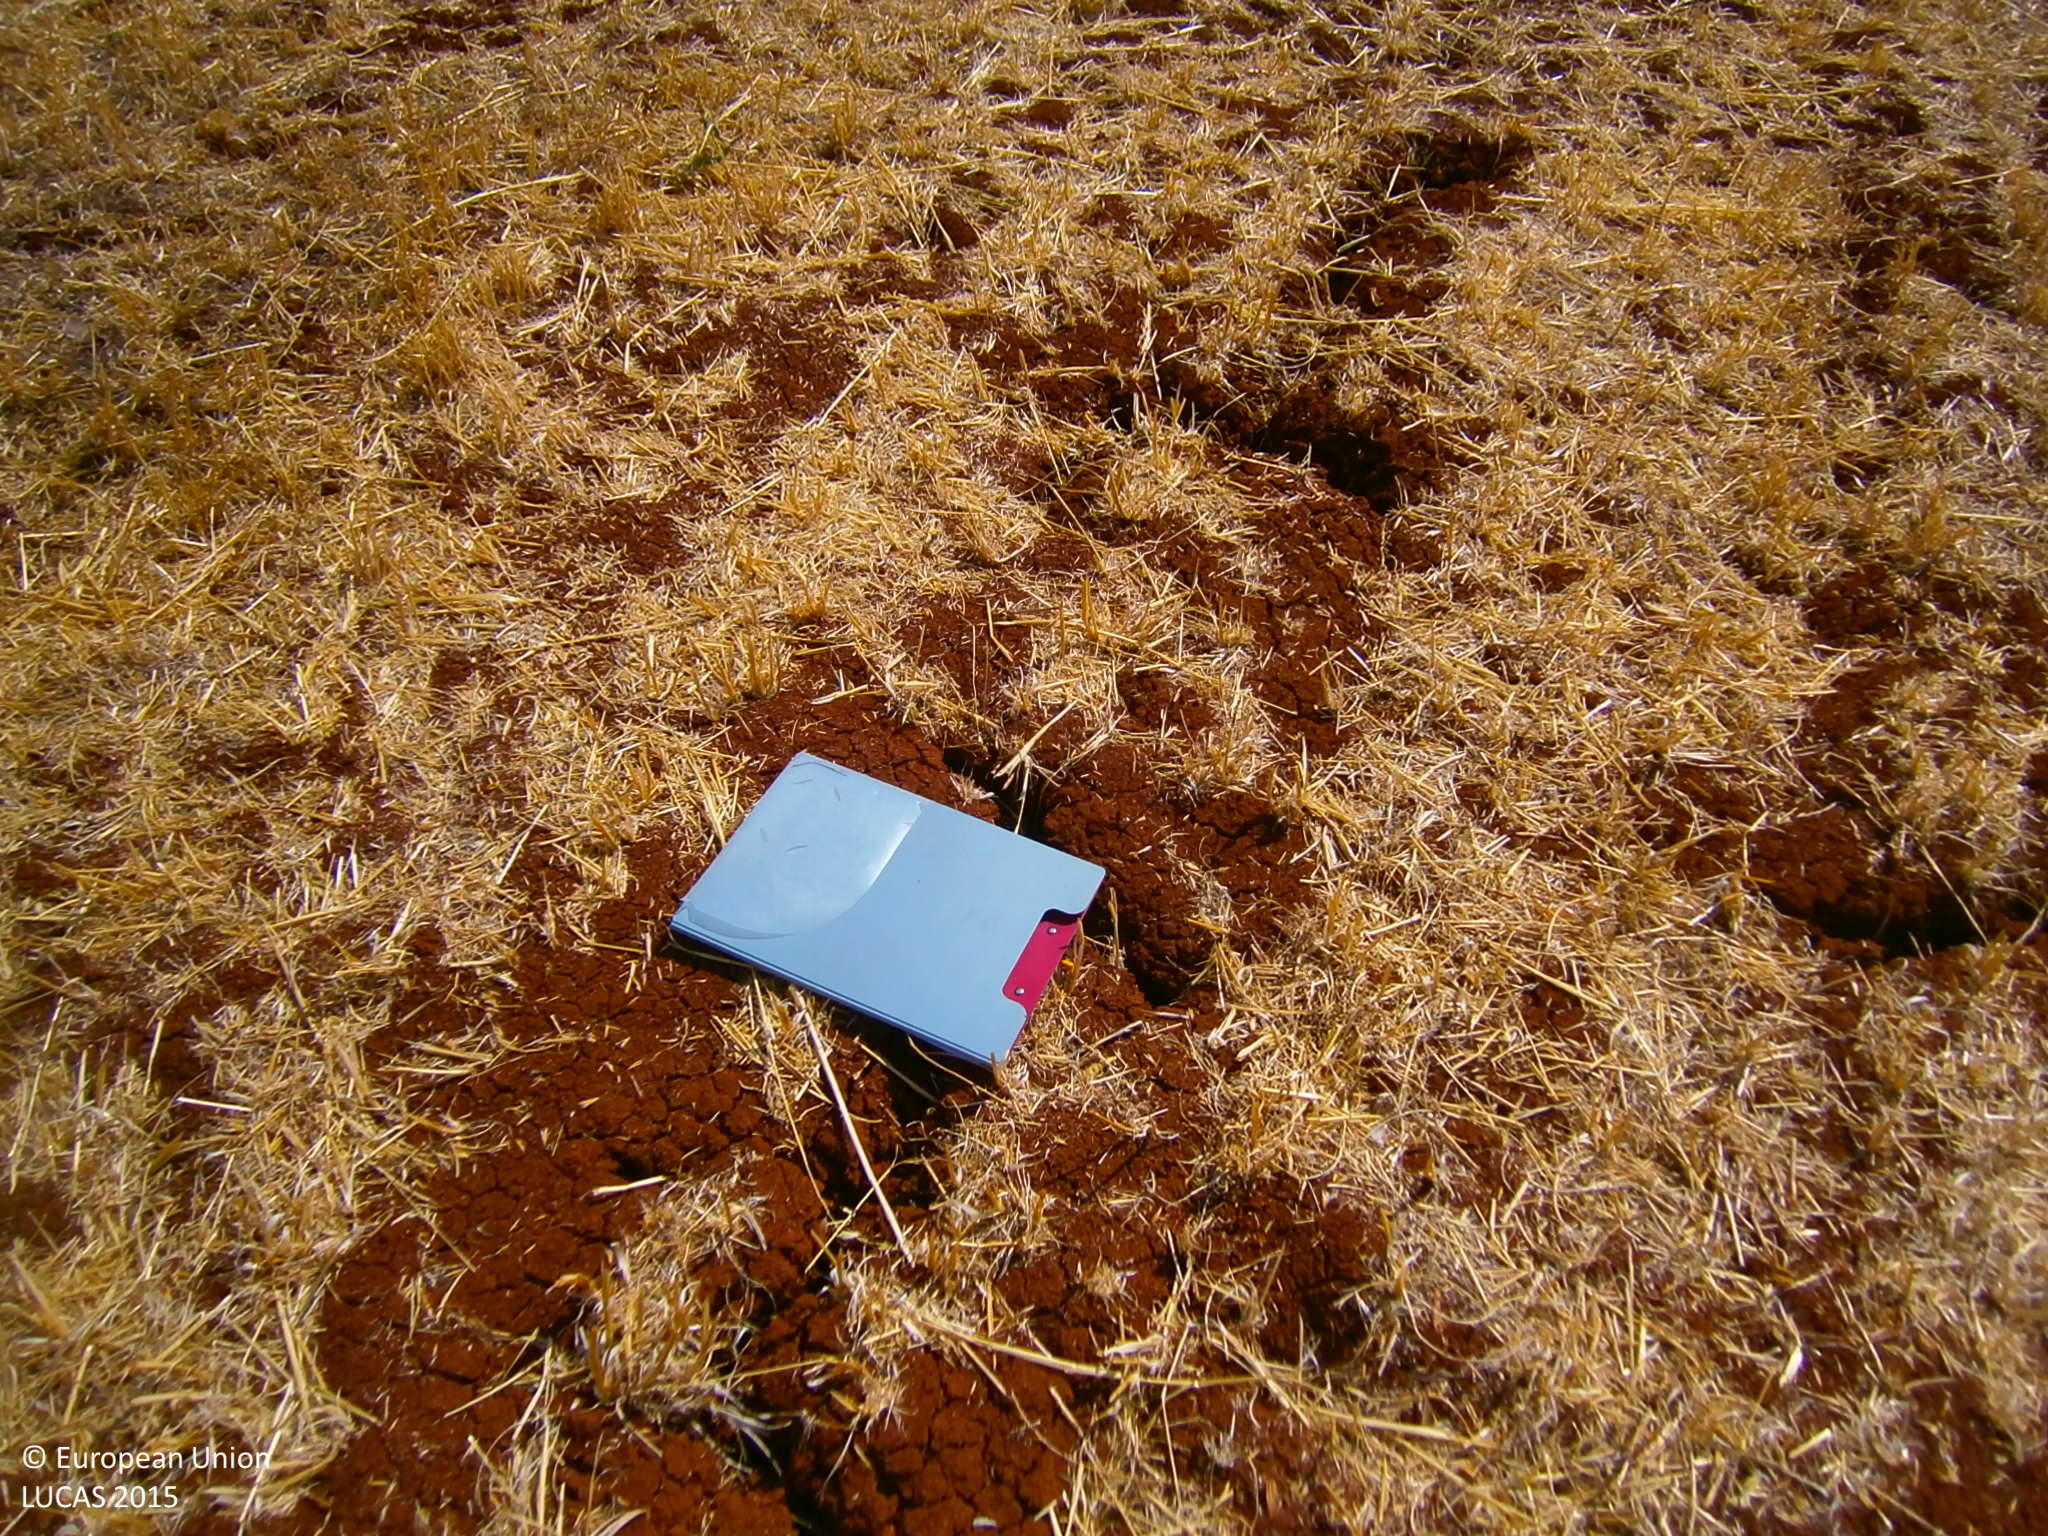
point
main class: Cropland
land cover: Barley
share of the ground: > 75 %
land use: Agriculture (excluding fallow land and kitchen gardens)
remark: Harvested field
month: July
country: ES
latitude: 38.7483
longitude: -6.9227
